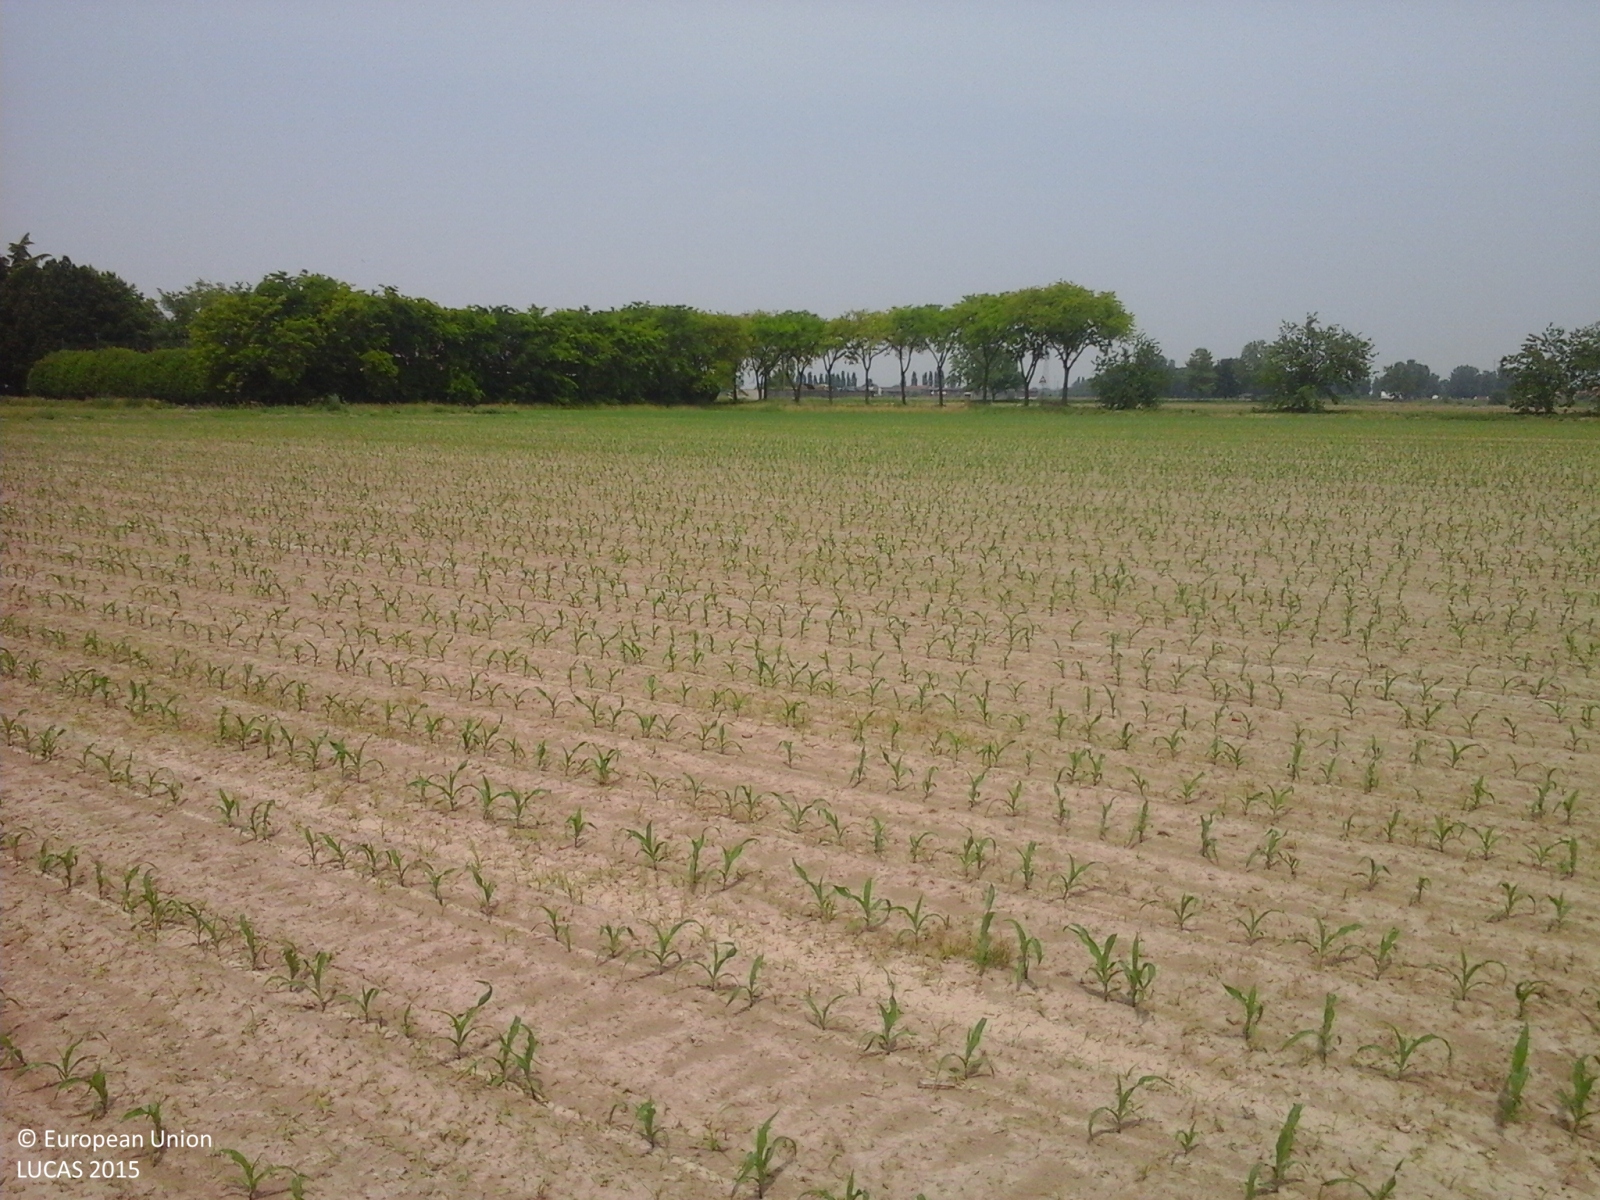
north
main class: Cropland
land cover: Maize
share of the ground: < 10 %
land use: Agriculture (excluding fallow land and kitchen gardens)
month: May
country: IT
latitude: 45.3399
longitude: 9.2994
